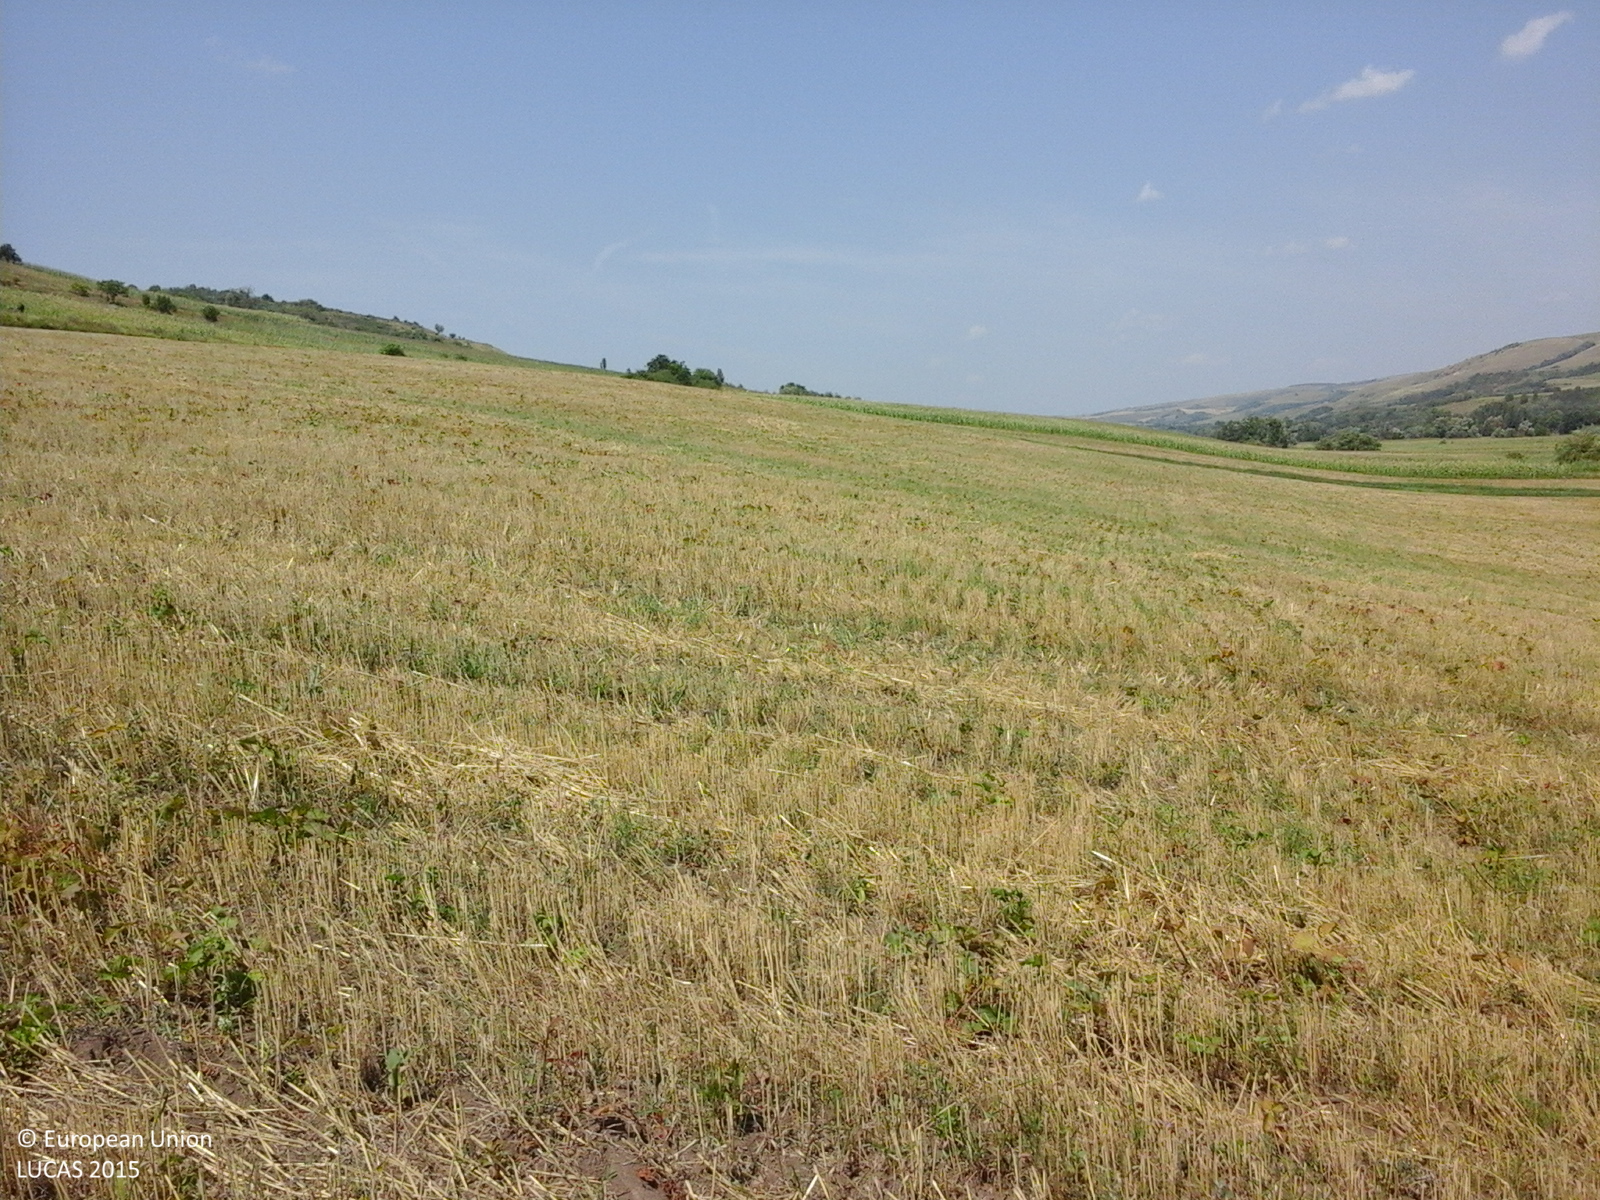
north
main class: Cropland
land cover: Maize
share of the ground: > 75 %
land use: Agriculture (excluding fallow land and kitchen gardens)
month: July
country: RO
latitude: 46.2718
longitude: 27.2961
